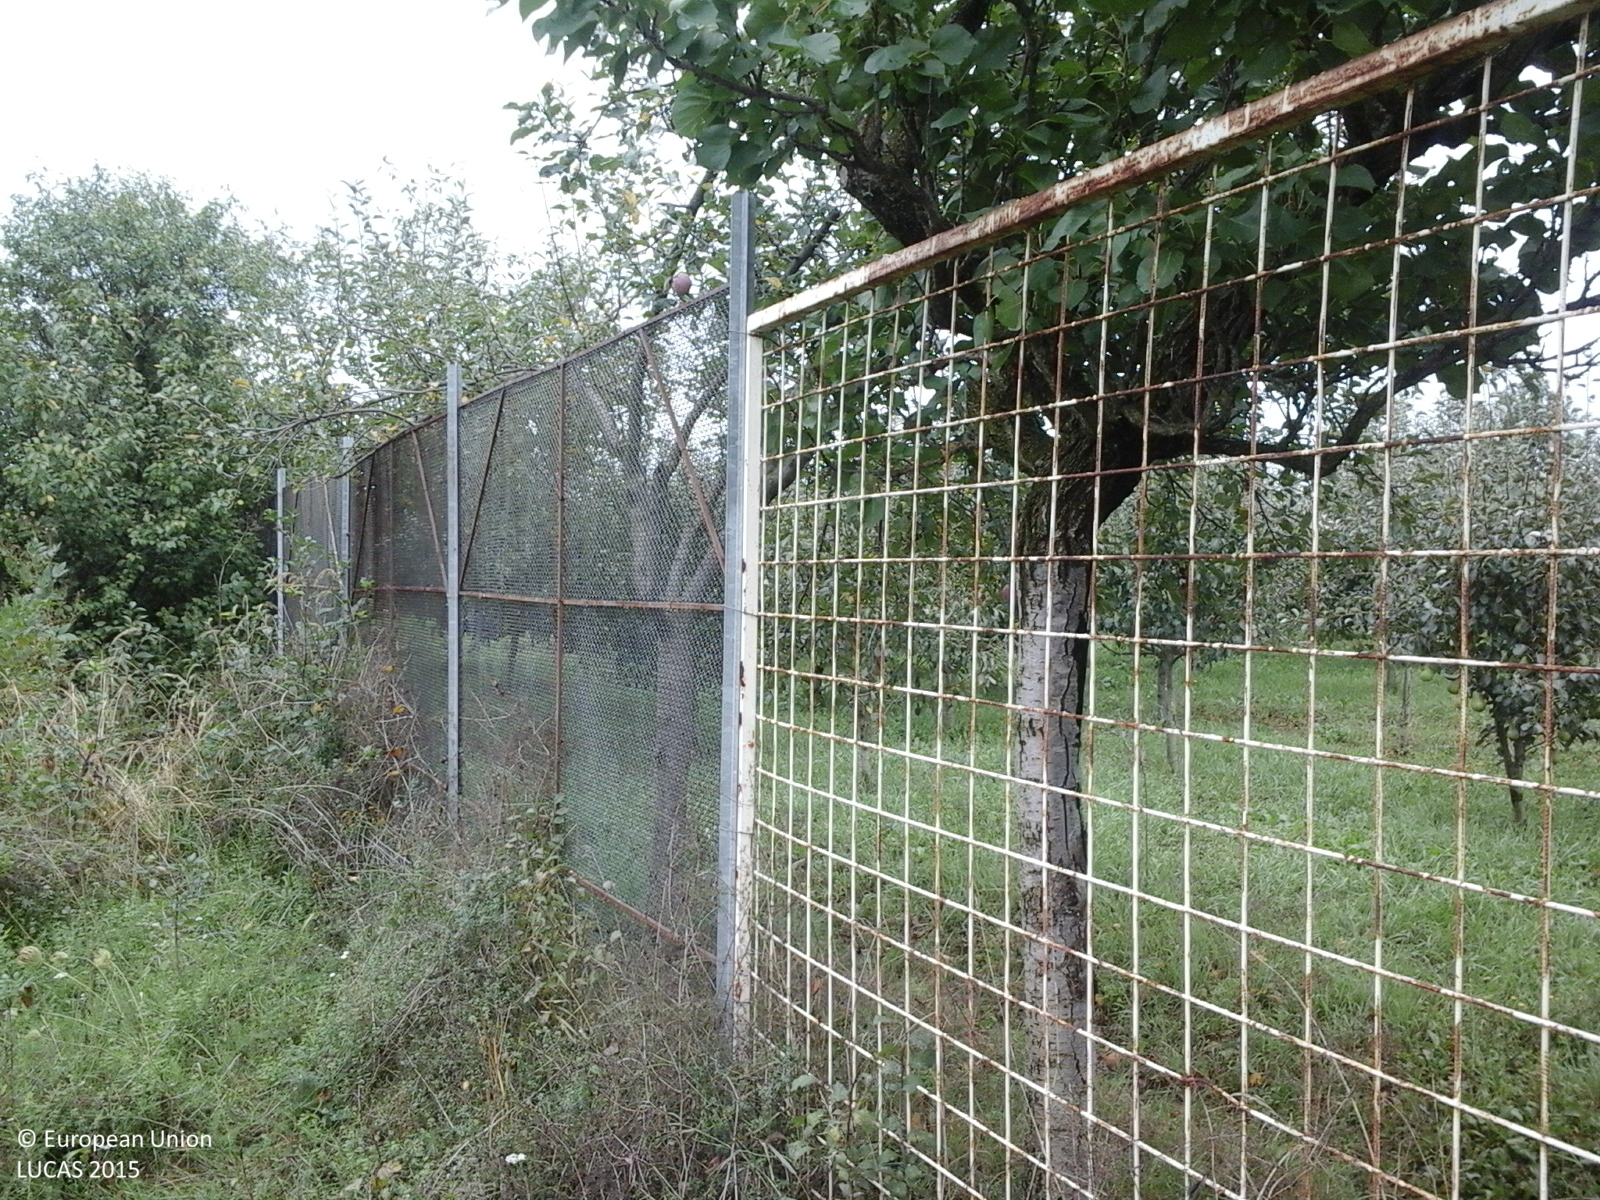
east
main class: Cropland
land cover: Maize
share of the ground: < 10 %
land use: Agriculture (excluding fallow land and kitchen gardens)
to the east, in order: Grass margins; Fences; Other fruit trees and berries; Maize; Artificial constructions in urban areas; Grassland without tree/shrub cover; Electric lines; Ditches and canals; Paved roads, cycling and walking lanes; Grassland without tree/shrub cover; Abandoned hedges
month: September
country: RO
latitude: 46.8914
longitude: 21.8433
